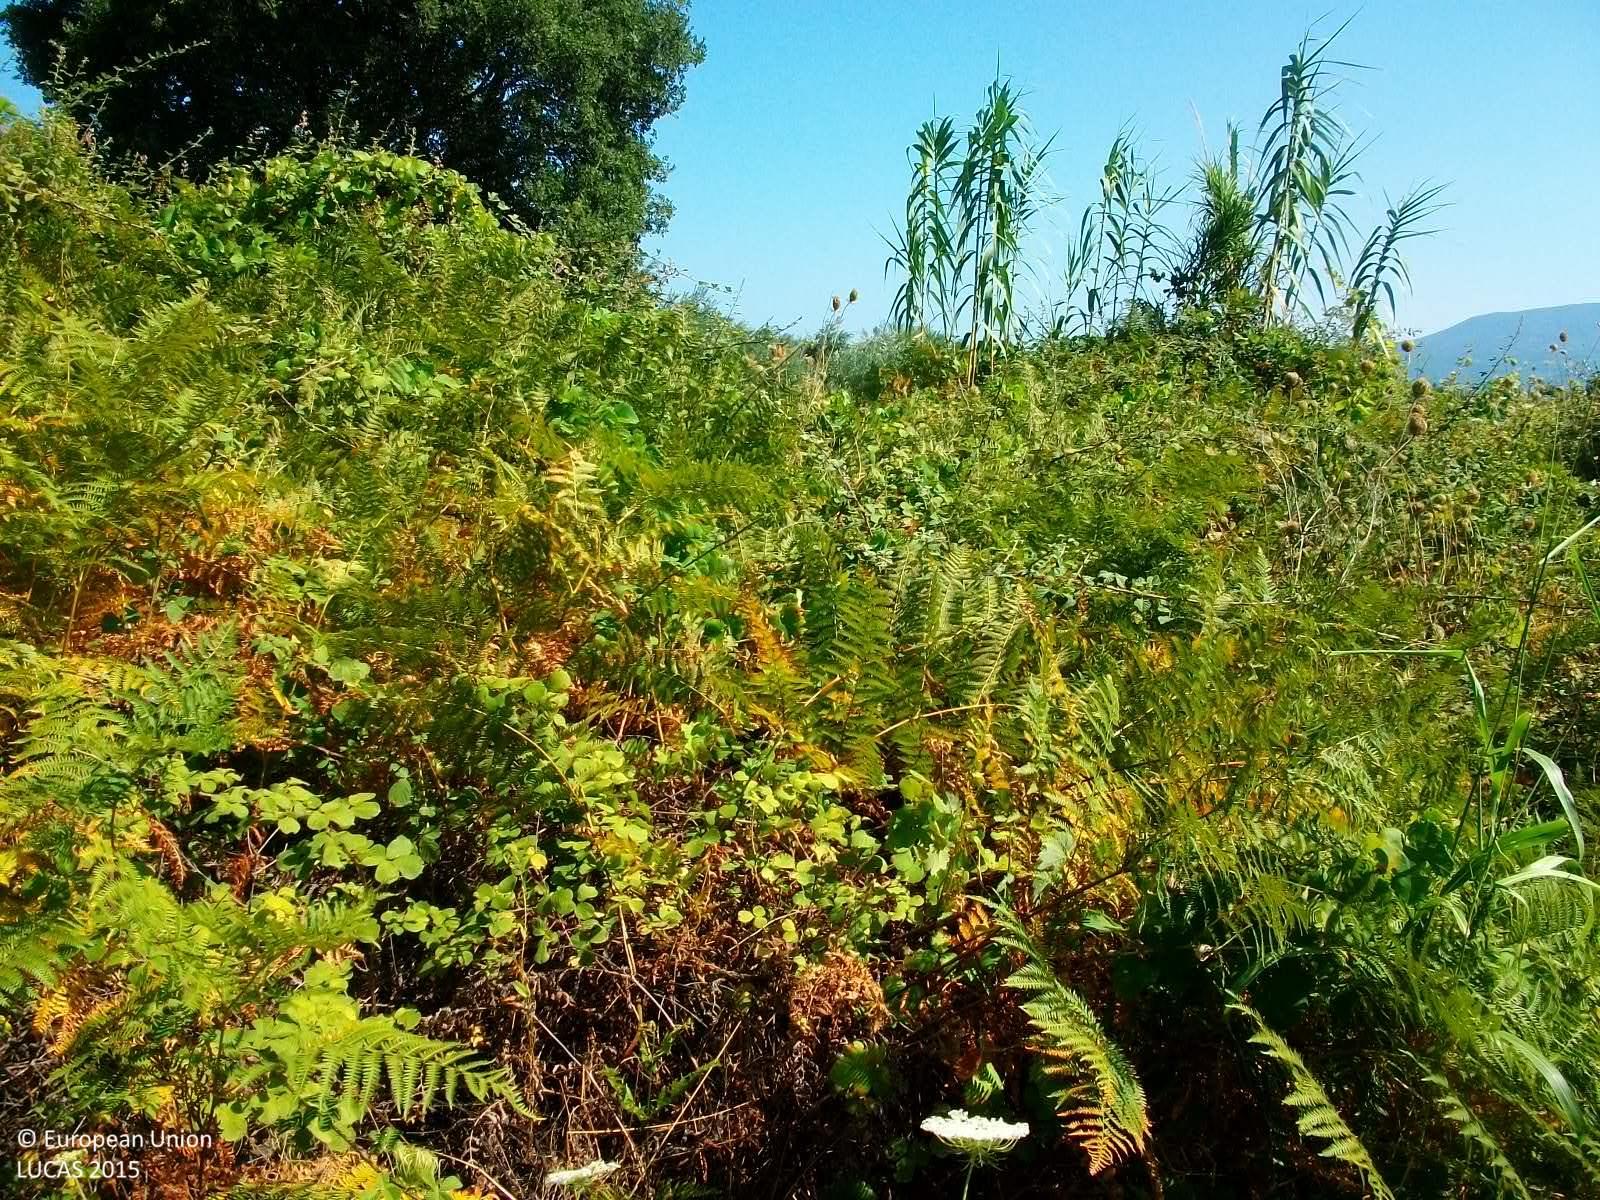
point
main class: Shrubland
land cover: Shrubland without tree cover
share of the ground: > 75 %
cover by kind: shrubs 100 %
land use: Abandoned areas
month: July
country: GR
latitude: 37.0365
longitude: 21.8805
